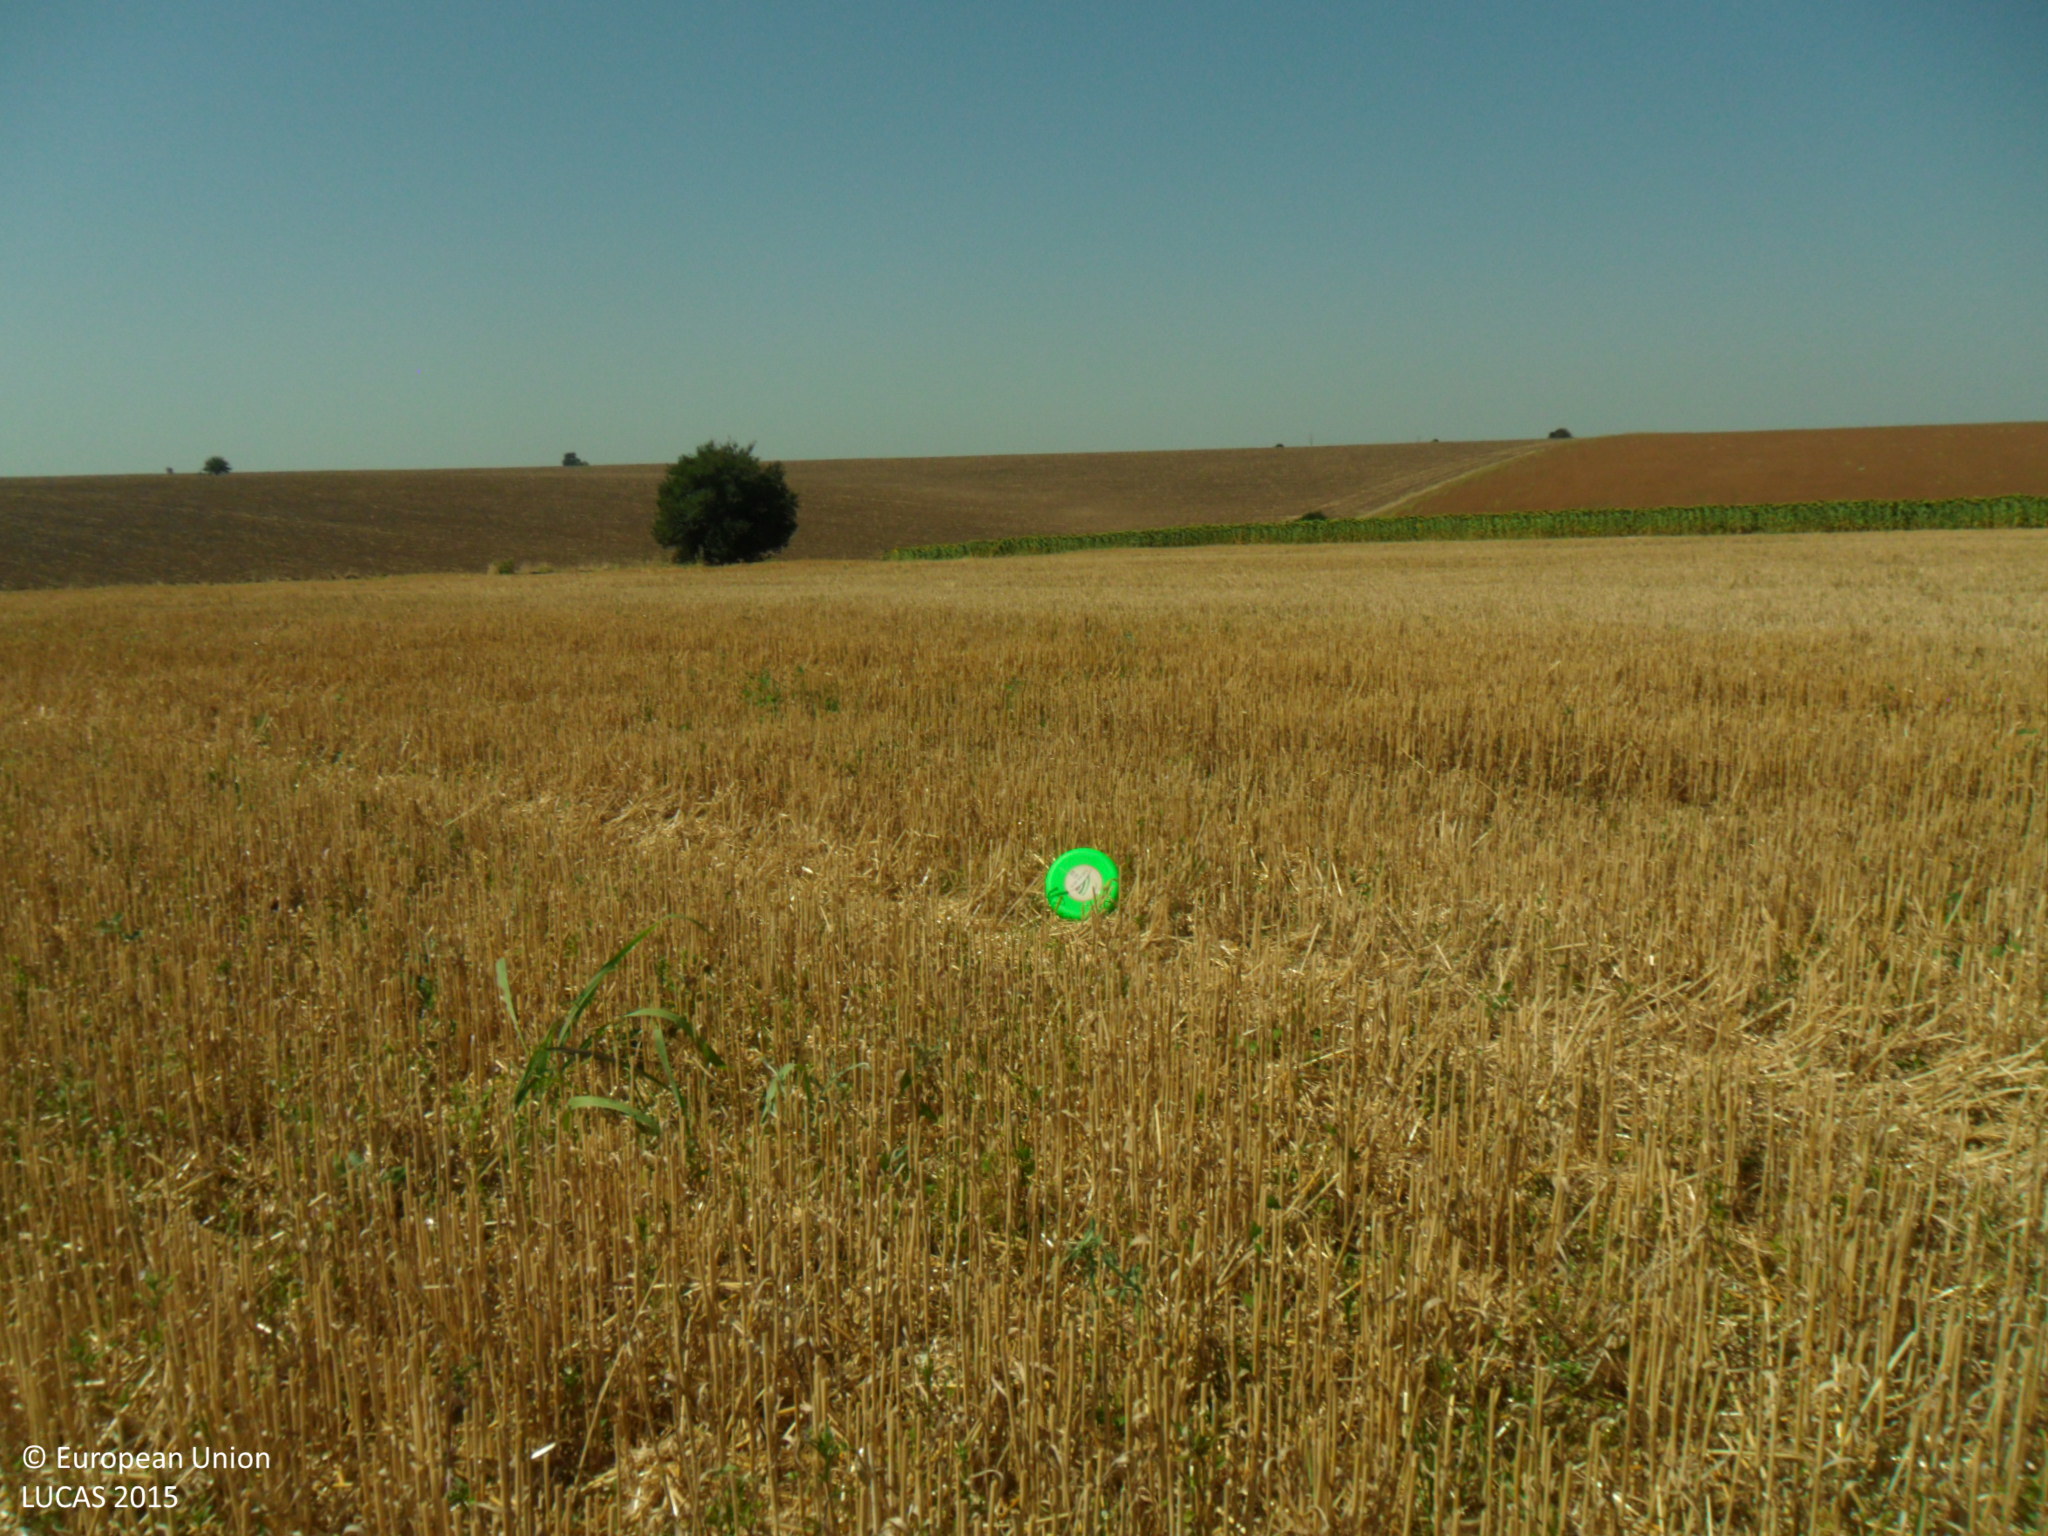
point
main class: Cropland
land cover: Common wheat
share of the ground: > 75 %
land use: Agriculture (excluding fallow land and kitchen gardens)
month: July
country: BG
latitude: 43.8436
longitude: 26.2854
